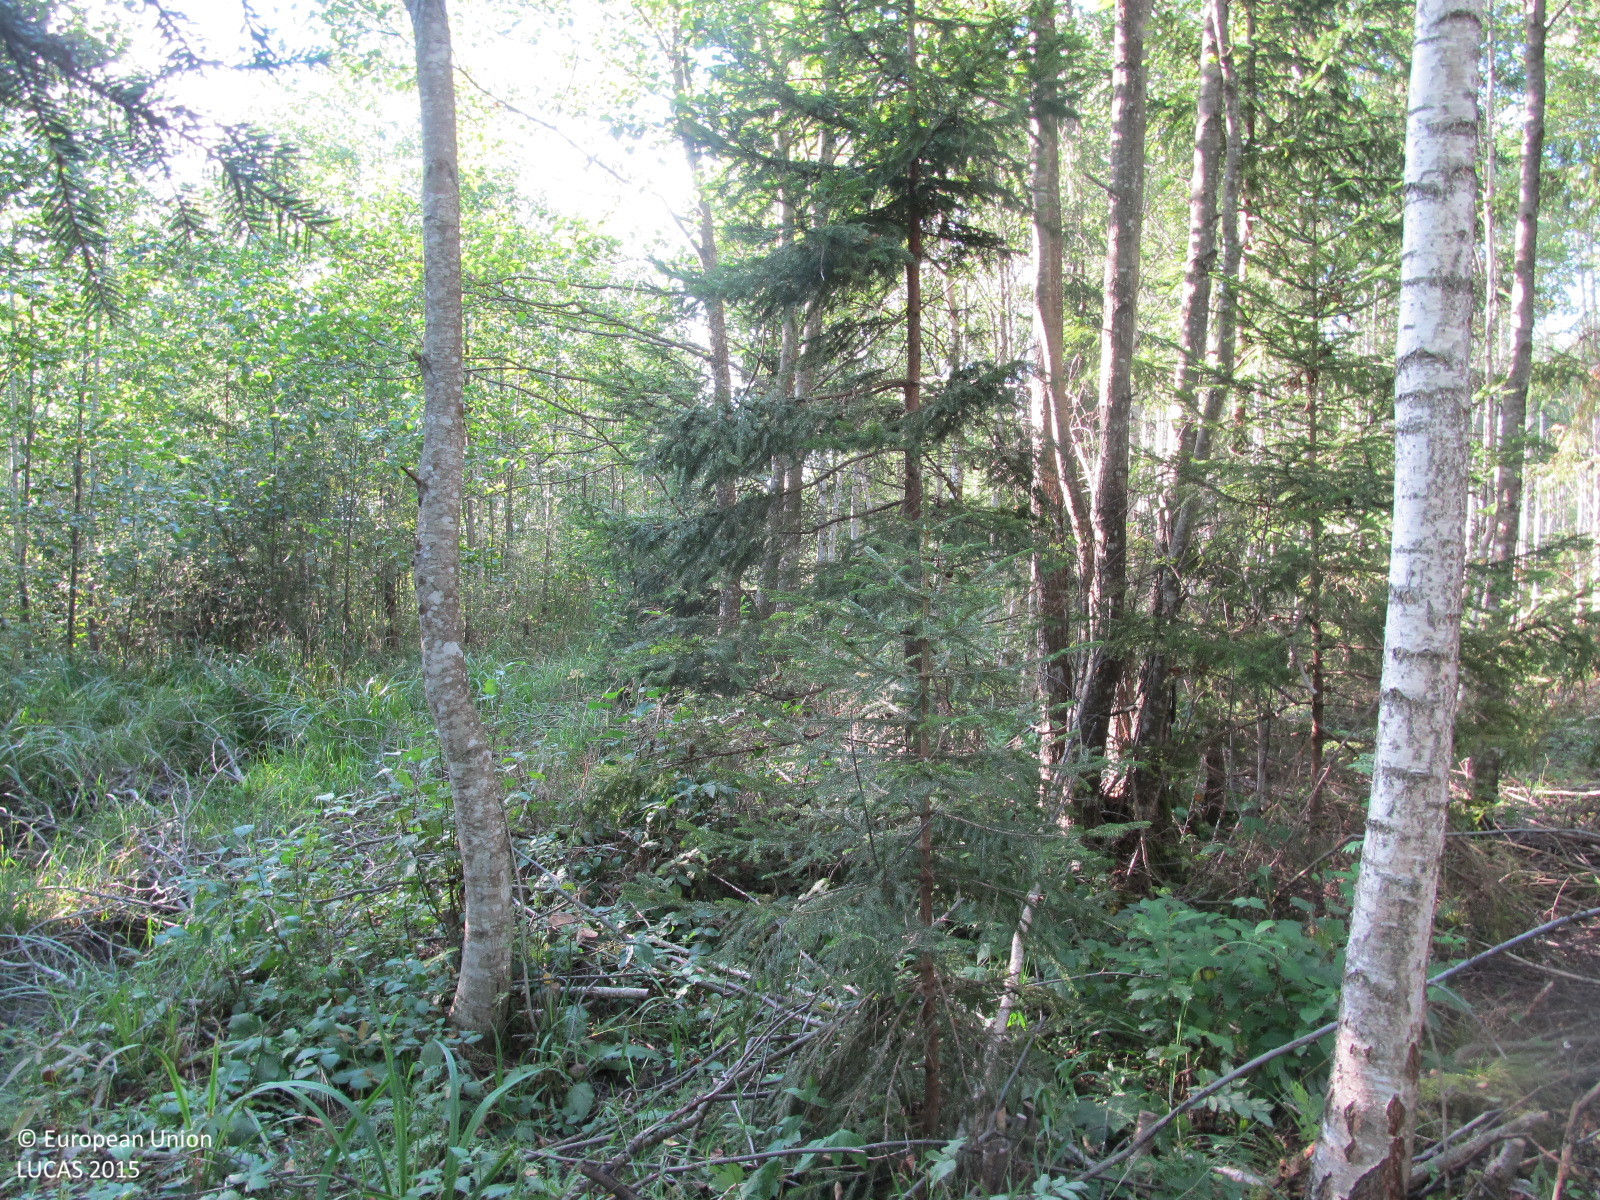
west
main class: Woodland
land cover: Broadleaved woodland
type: non-riverine alder, birch or aspen forest
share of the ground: 50 - 75 %
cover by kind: broadleaved forest trees 60 %, herbaceous plants 20 %, coniferous forest trees 10 %, lichens and mosses 5 %, unconsolidated bare surface 5 %
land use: Forestry
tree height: > 5 m
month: September
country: LT
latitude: 56.1221
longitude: 23.3771
